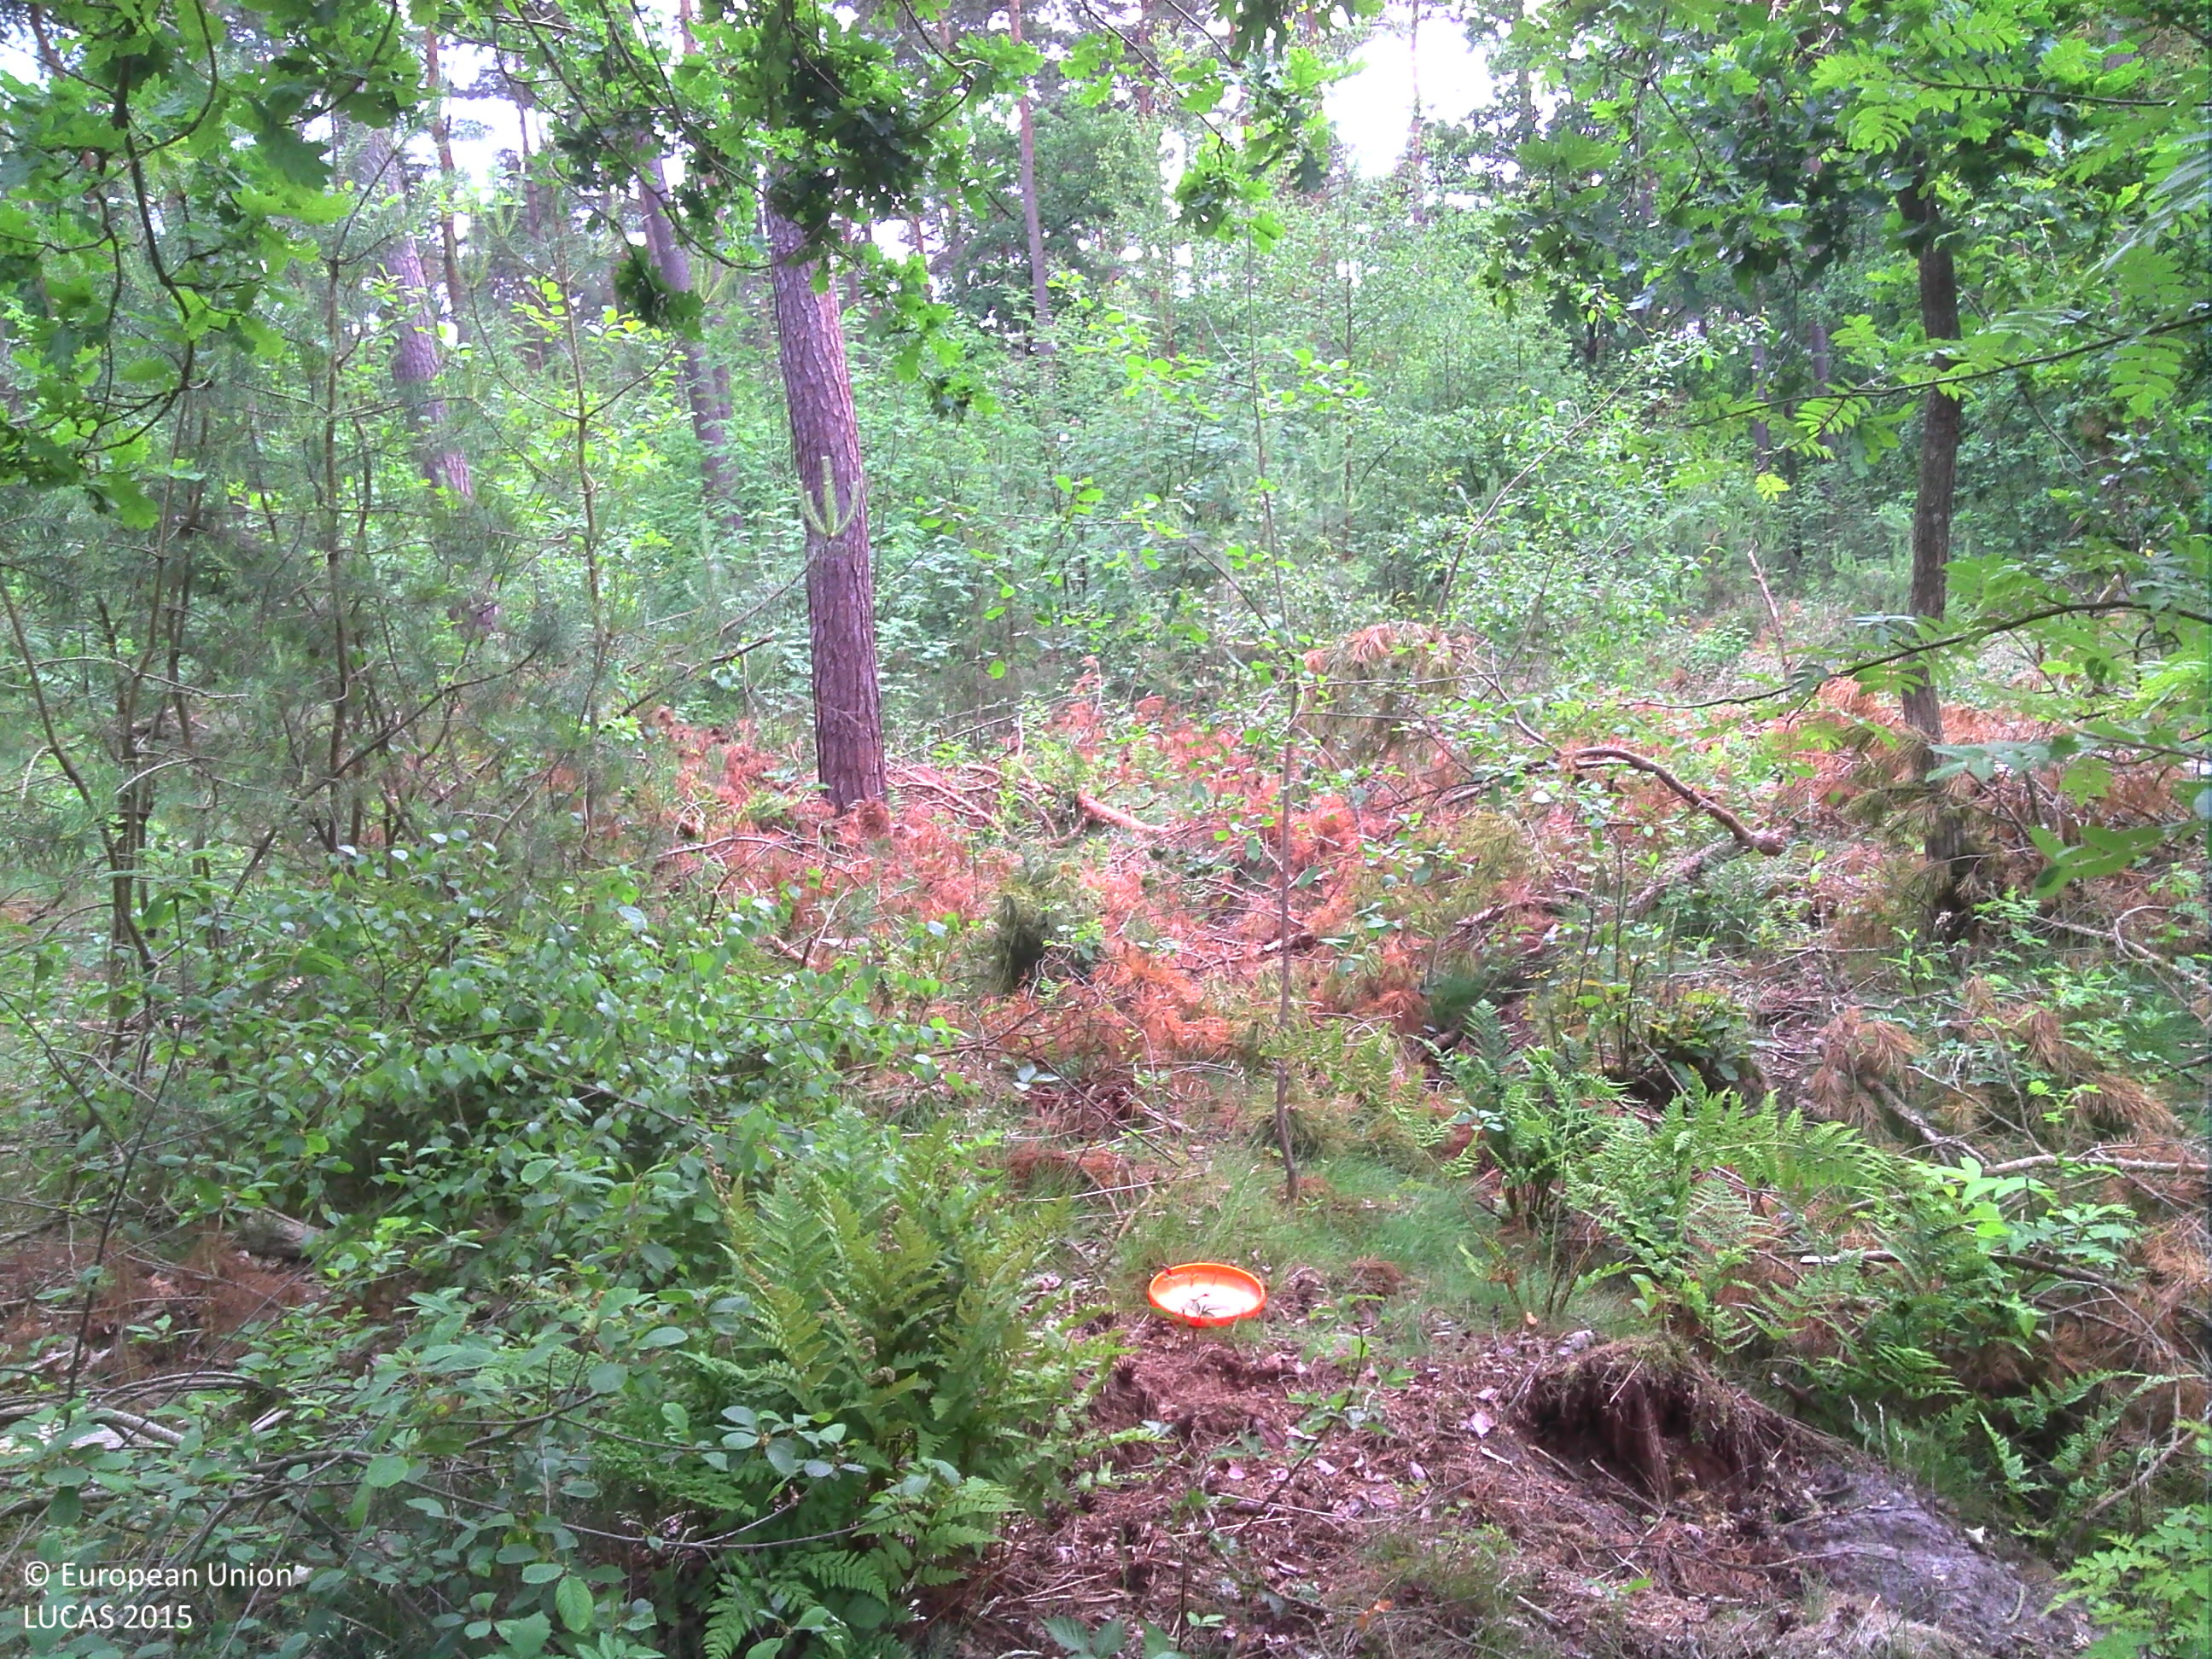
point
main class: Woodland
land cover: Pine dominated mixed woodland
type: exotic forest
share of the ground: > 75 %
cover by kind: coniferous forest trees 75 %, broadleaved forest trees 25 %
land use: Forestry
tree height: > 5 m
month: June
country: BE
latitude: 51.1283
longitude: 5.2107
